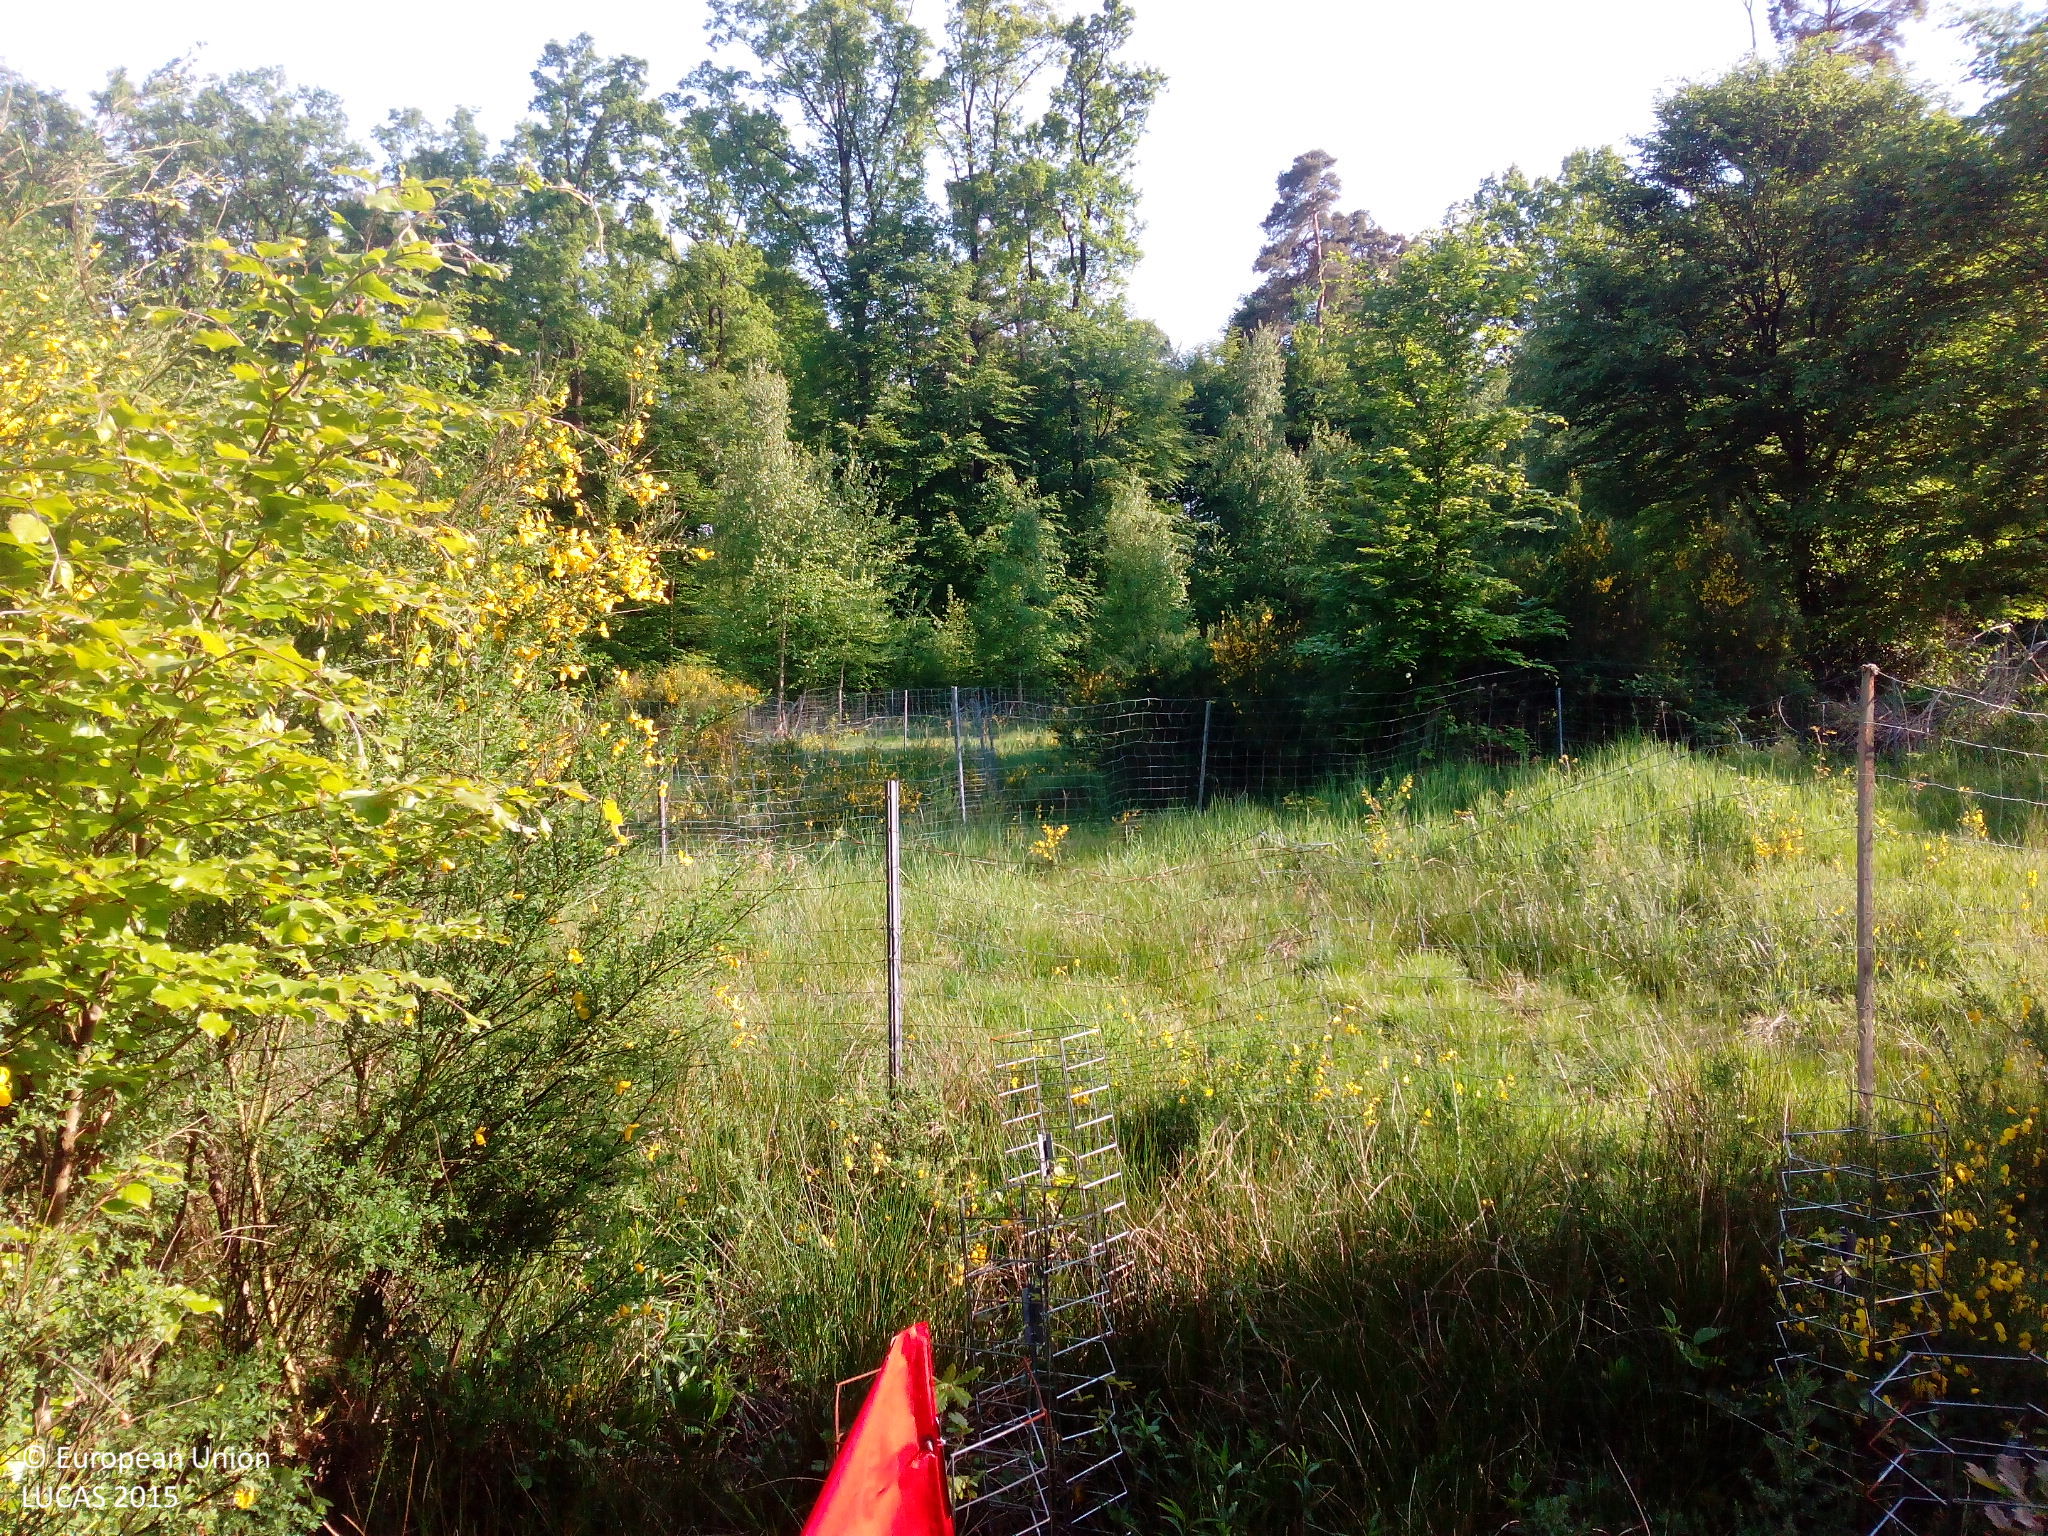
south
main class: Woodland
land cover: Broadleaved woodland
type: beech forest
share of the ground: 50 - 75 %
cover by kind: broadleaved forest trees 60 %, herbaceous plants 30 %, shrubs 5 %, unconsolidated bare surface 5 %
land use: Forestry
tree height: > 5 m
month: May
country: DE
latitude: 48.9820
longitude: 8.1560
